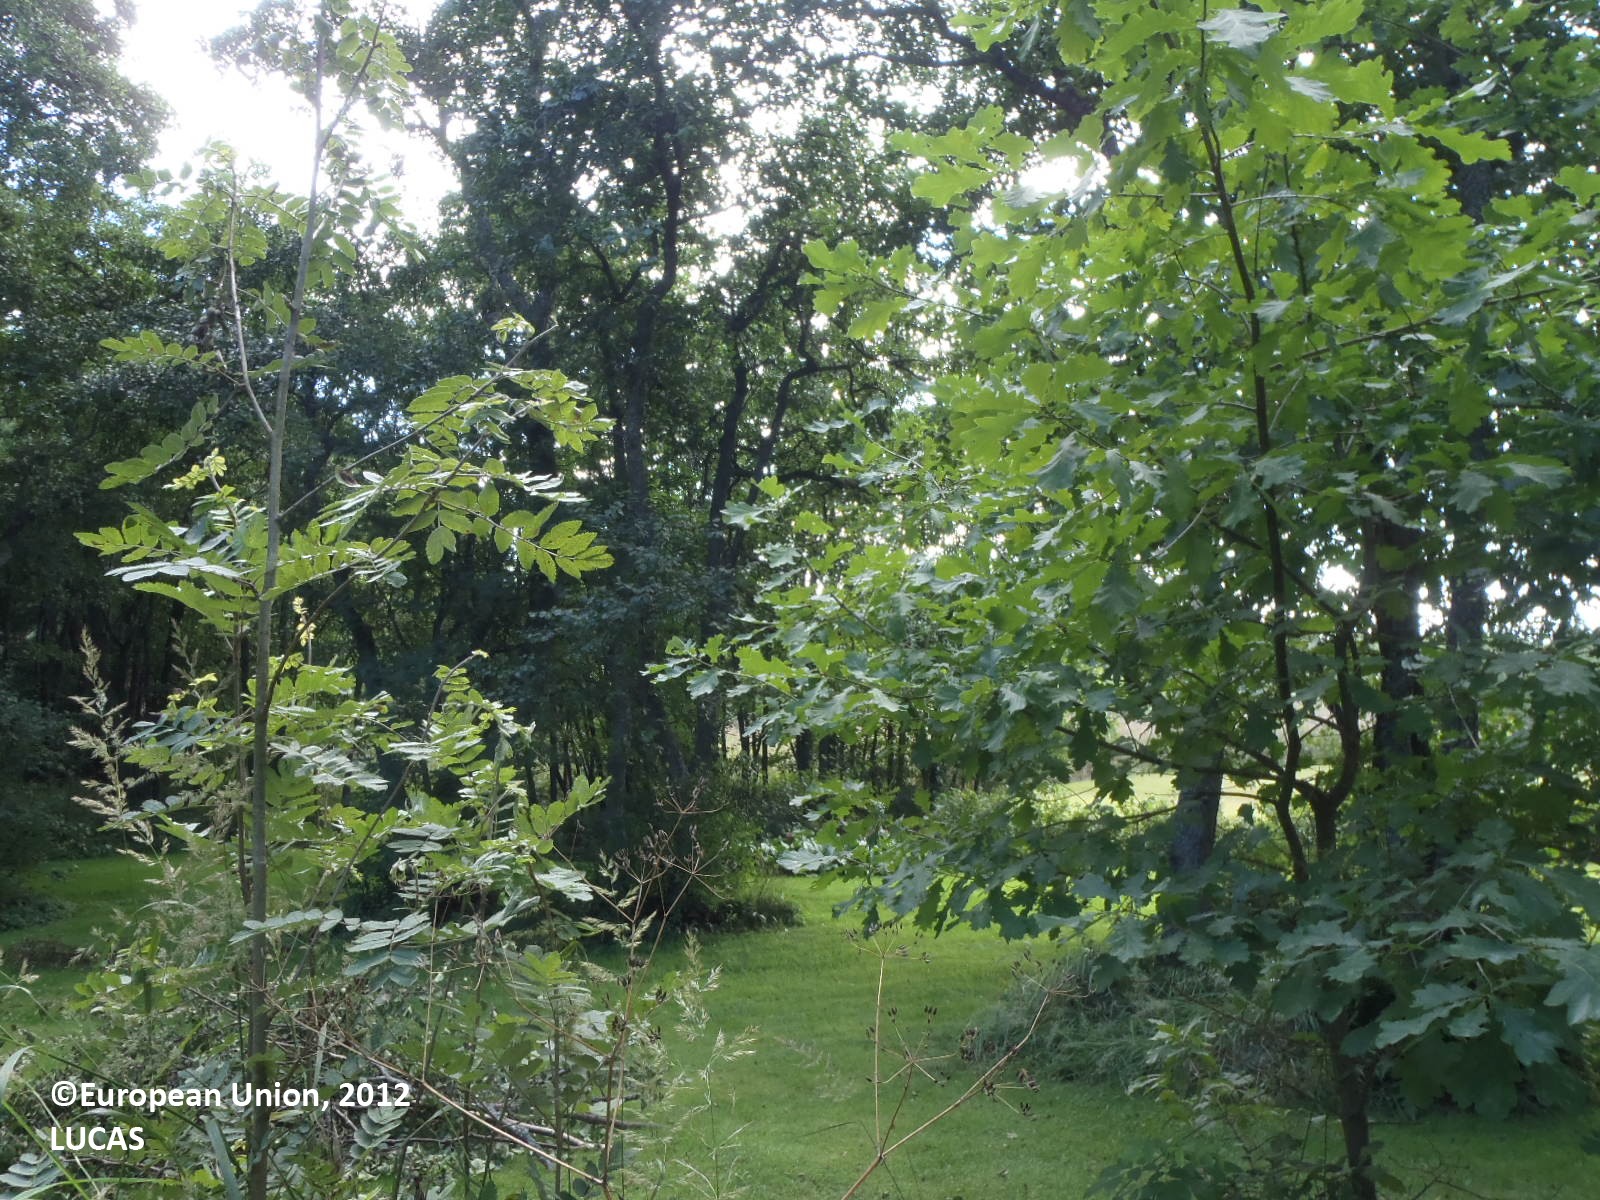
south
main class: Woodland
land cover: Pine dominated mixed woodland
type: boreal forest
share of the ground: 25 - 50 %
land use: Residential
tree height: > 5 m
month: August
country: FI
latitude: 60.1552
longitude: 21.8264
